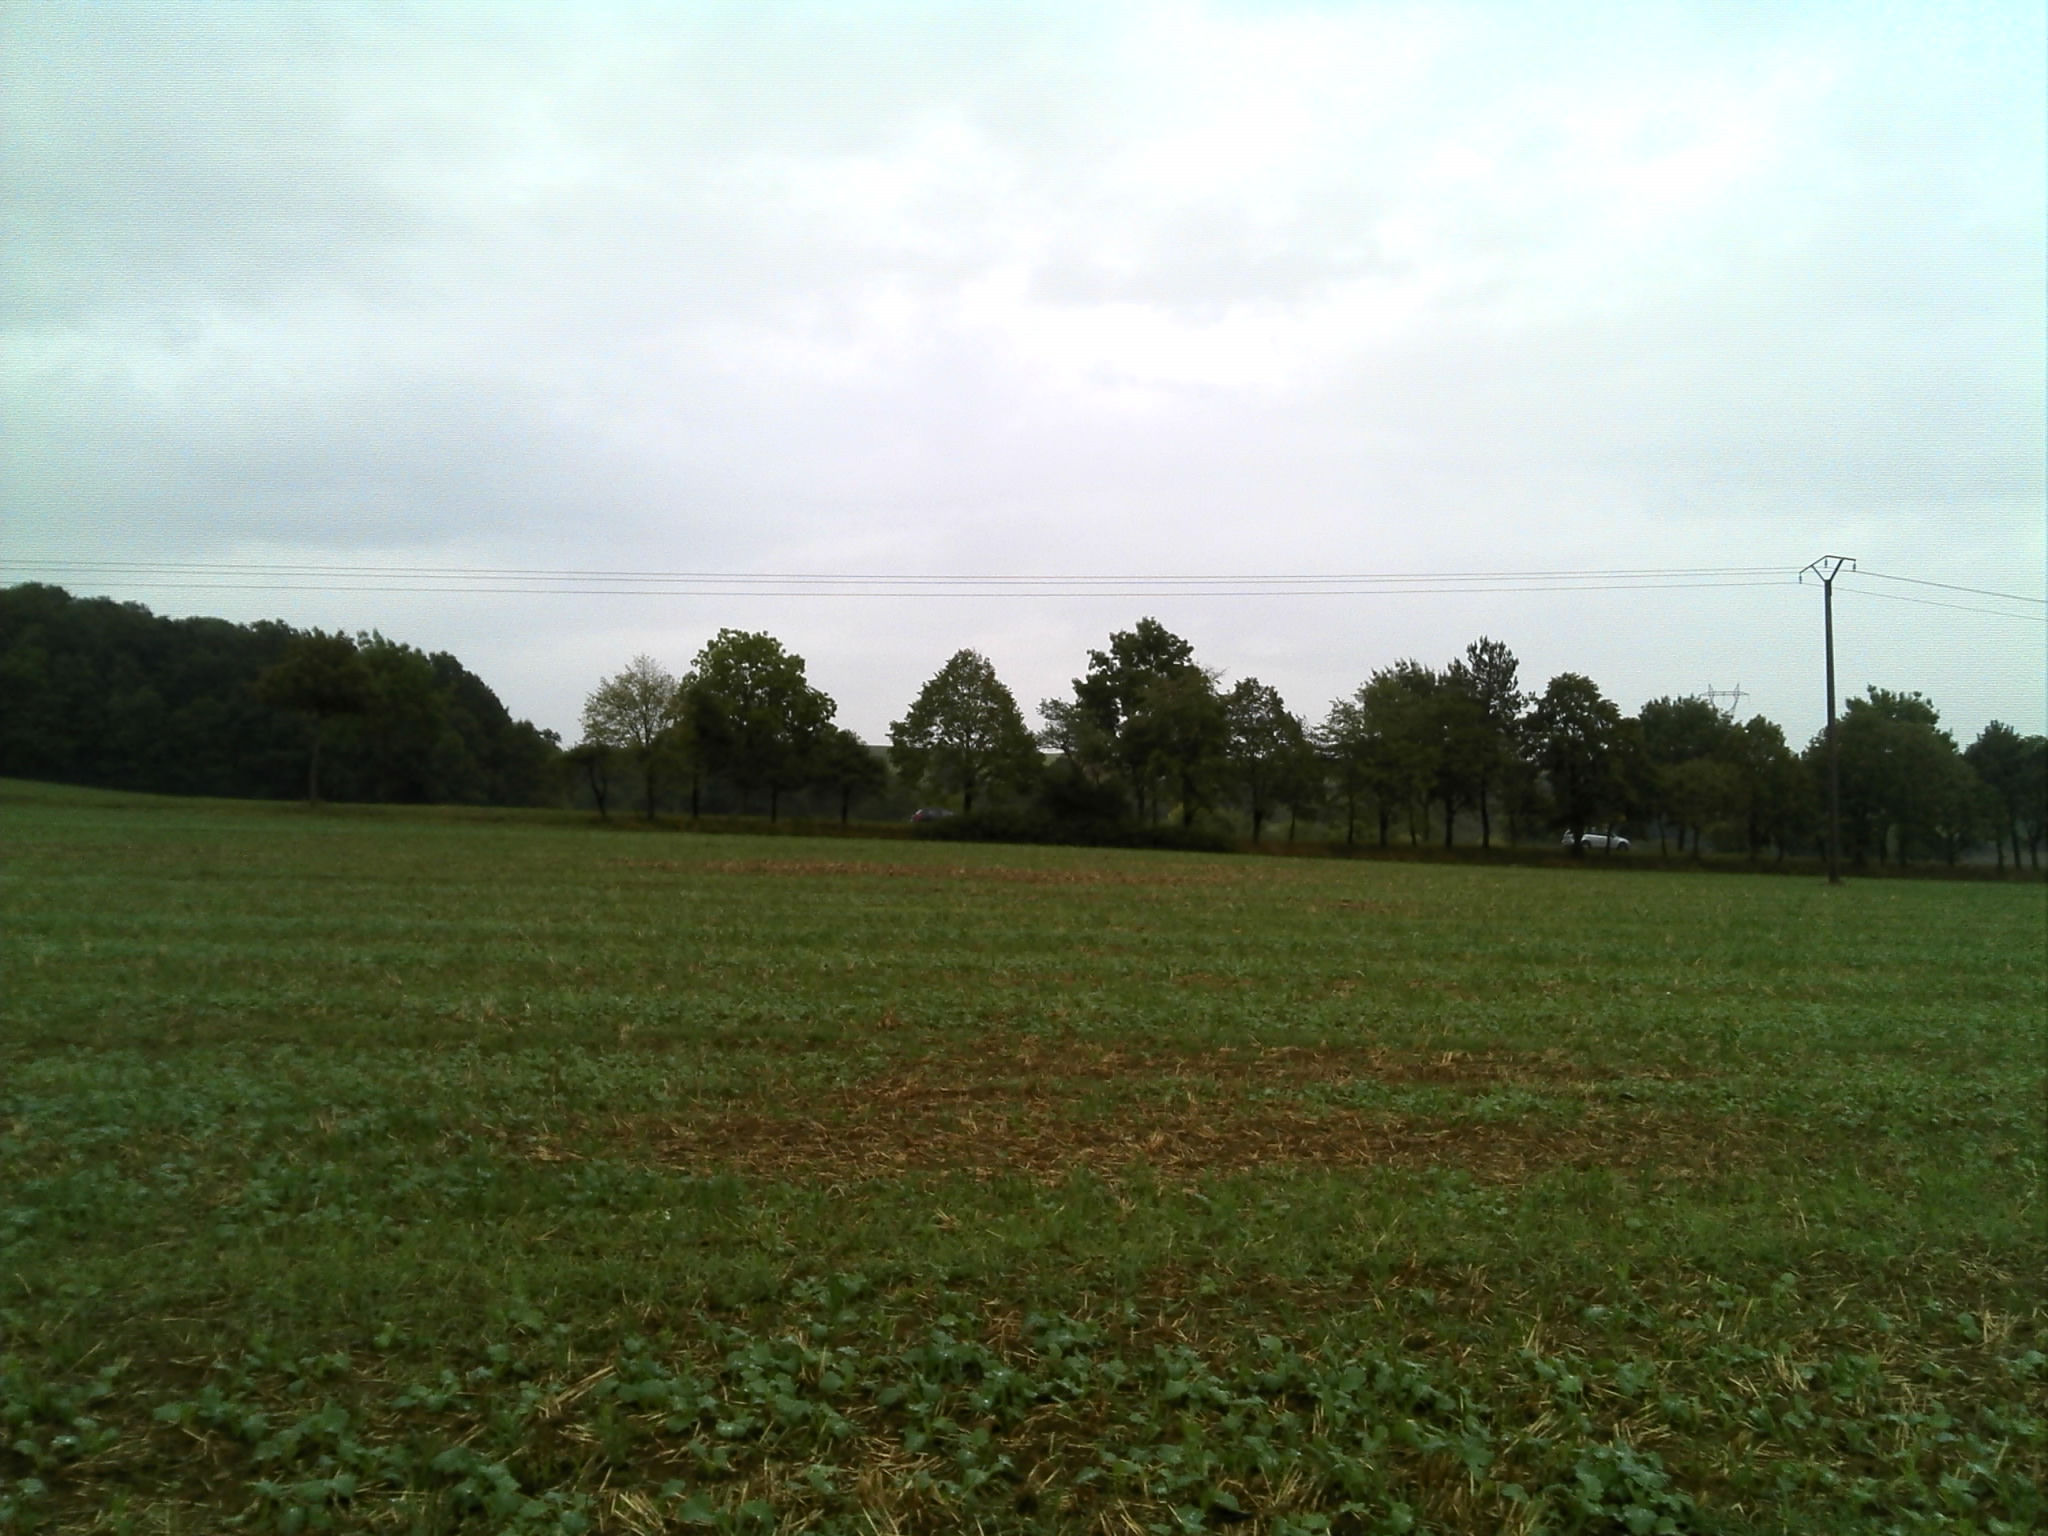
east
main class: Cropland
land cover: Rape and turnip rape
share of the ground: < 10 %
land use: Agriculture (excluding fallow land and kitchen gardens)
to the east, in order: Rape and turnip rape; Electric lines; Rape and turnip rape; Grass margins; Lines of trees; Grass margins; Paved roads, cycling and walking lanes; Grass margins; Lines of trees; Grassland without tree/shrub cover
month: September
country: FR
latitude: 49.3367
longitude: 5.9119
